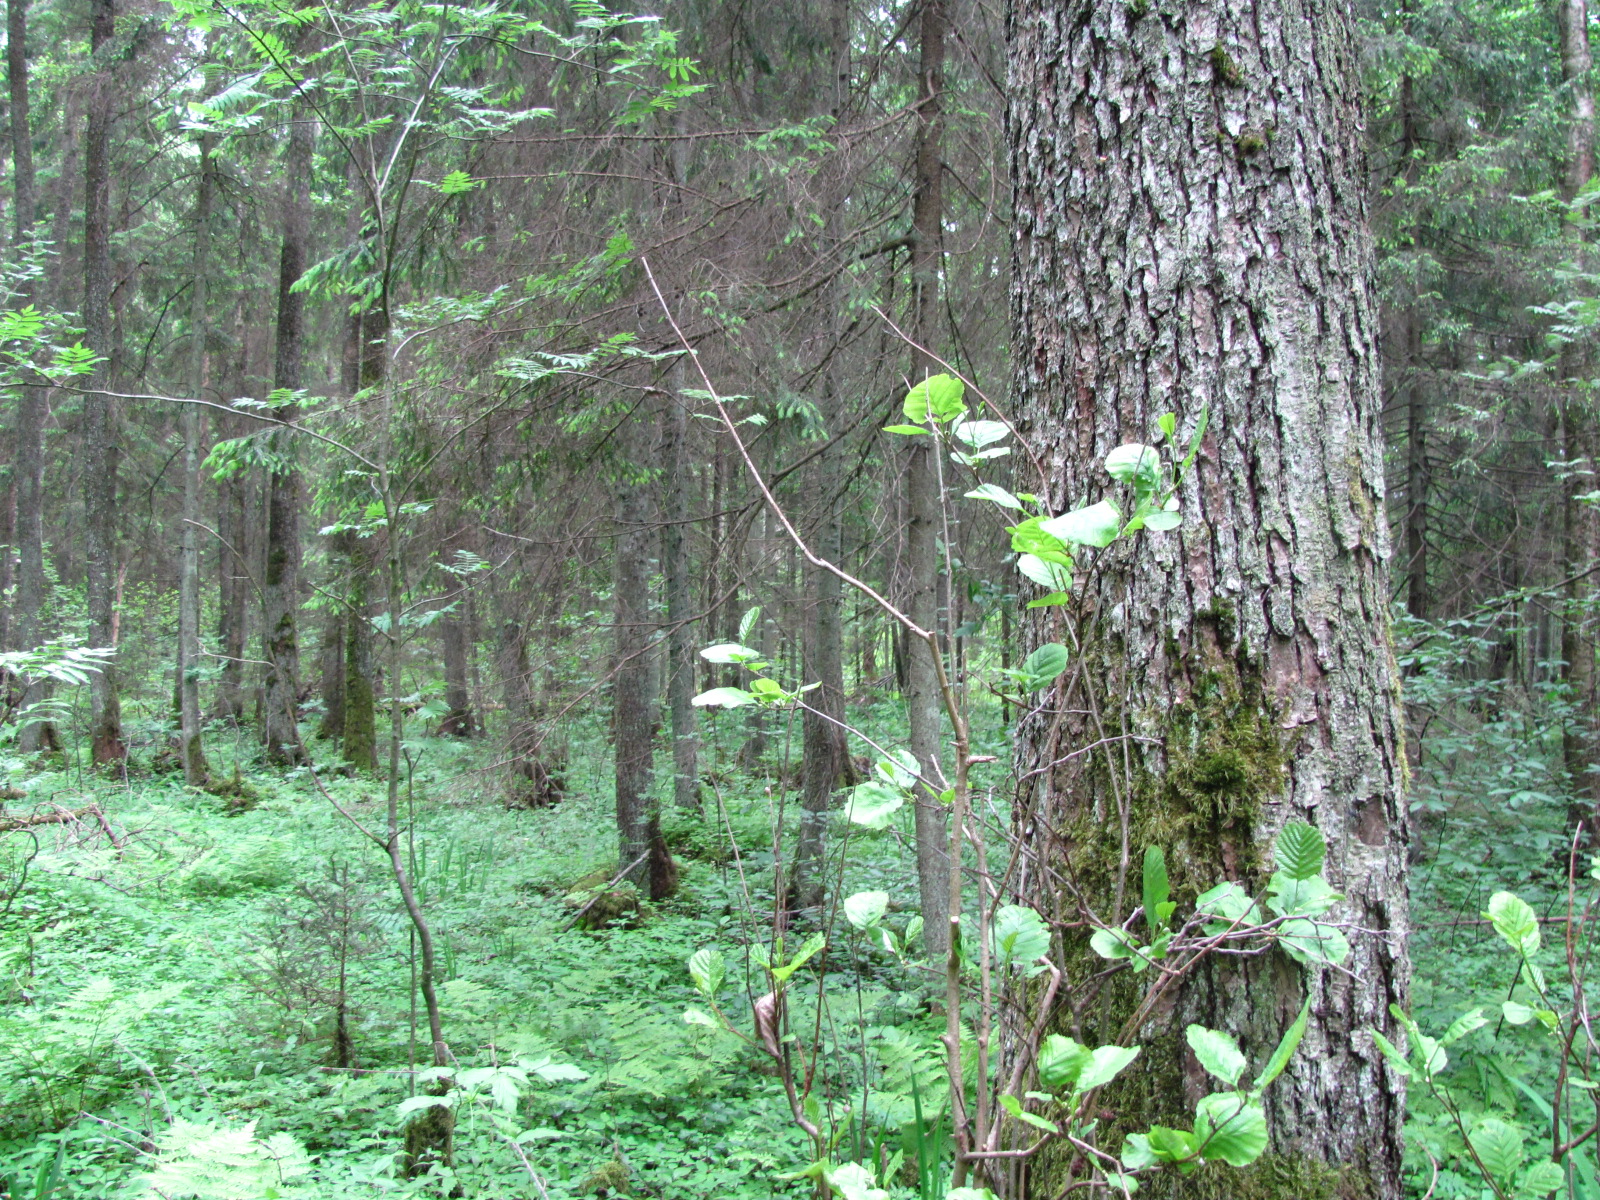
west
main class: Woodland
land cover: Spruce dominated mixed woodland
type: hemiboreal forest and nemoral coniferous forest and mixed broadleaved-coniferous forest
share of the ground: > 75 %
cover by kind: coniferous forest trees 50 %, broadleaved forest trees 50 %
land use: Forestry
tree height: > 5 m
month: June
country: LV
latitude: 56.8341
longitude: 24.0655
